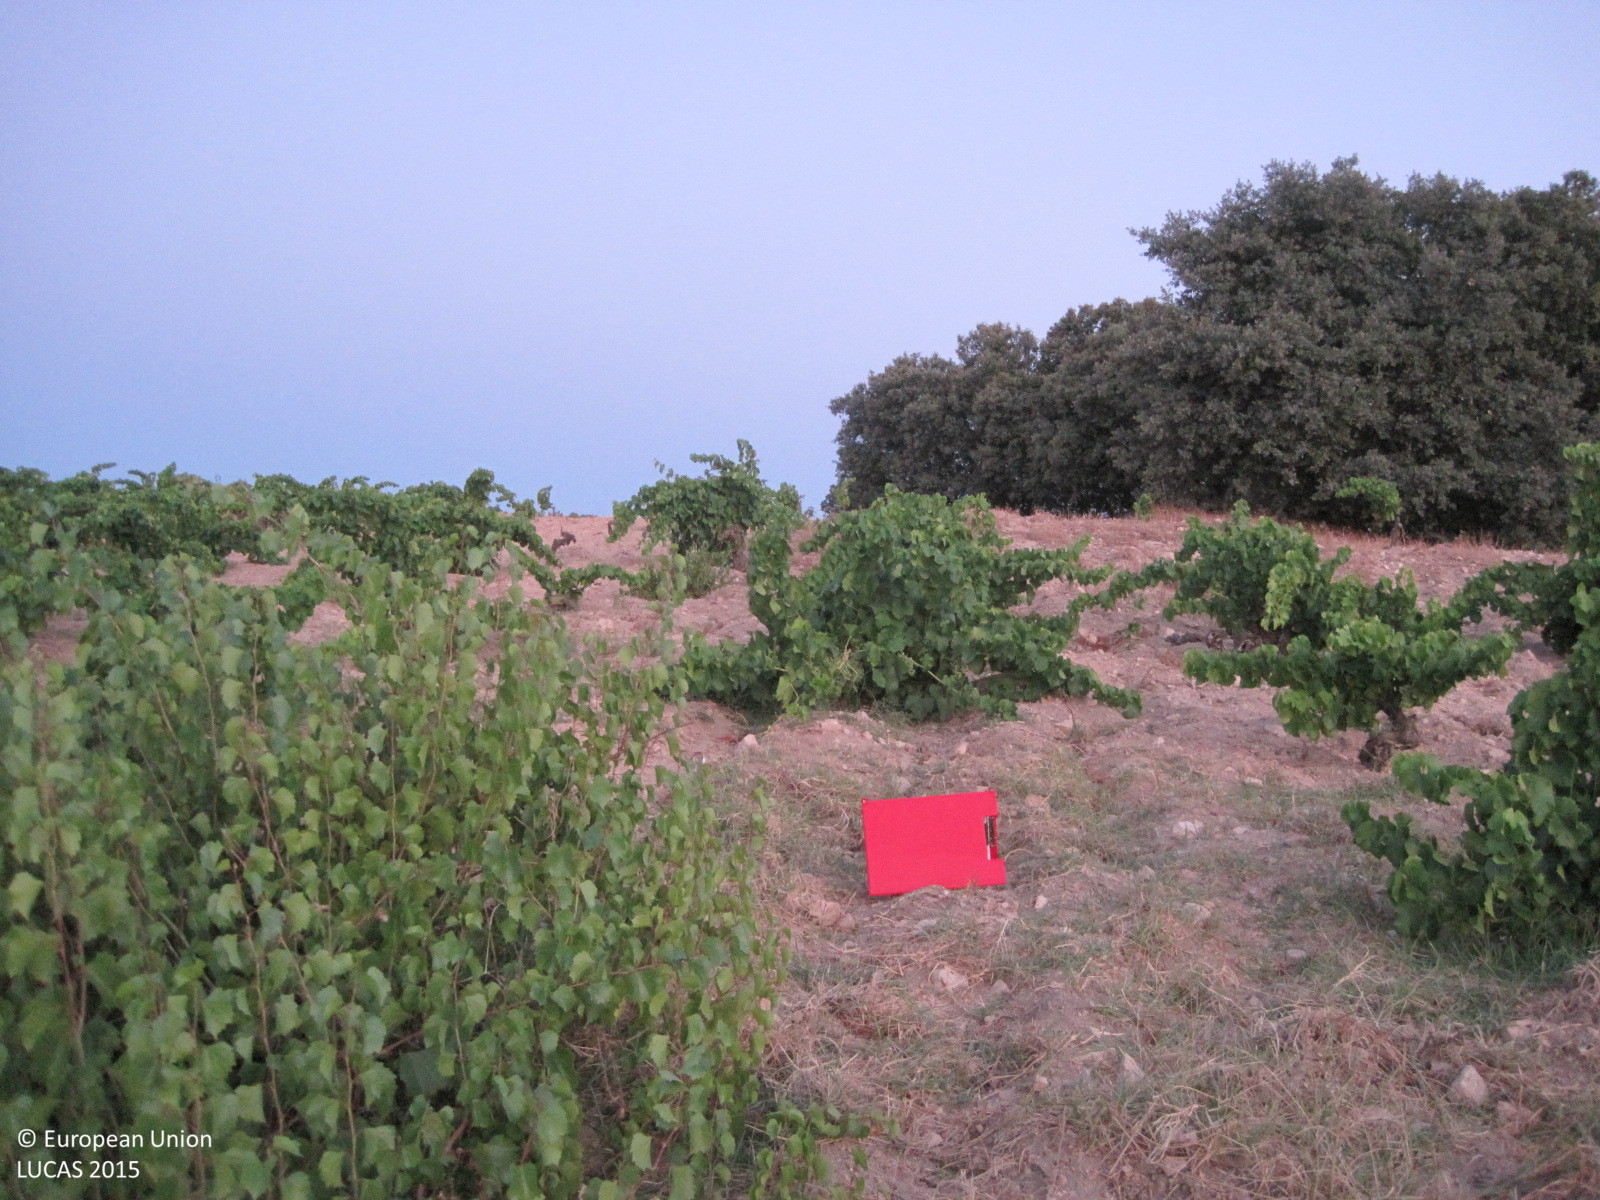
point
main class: Cropland
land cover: Vineyards
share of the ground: 50 - 75 %
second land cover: Grassland without tree/shrub cover
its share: 25 - 50 %
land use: Agriculture (excluding fallow land and kitchen gardens)
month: July
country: ES
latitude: 40.3510
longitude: -4.4227
